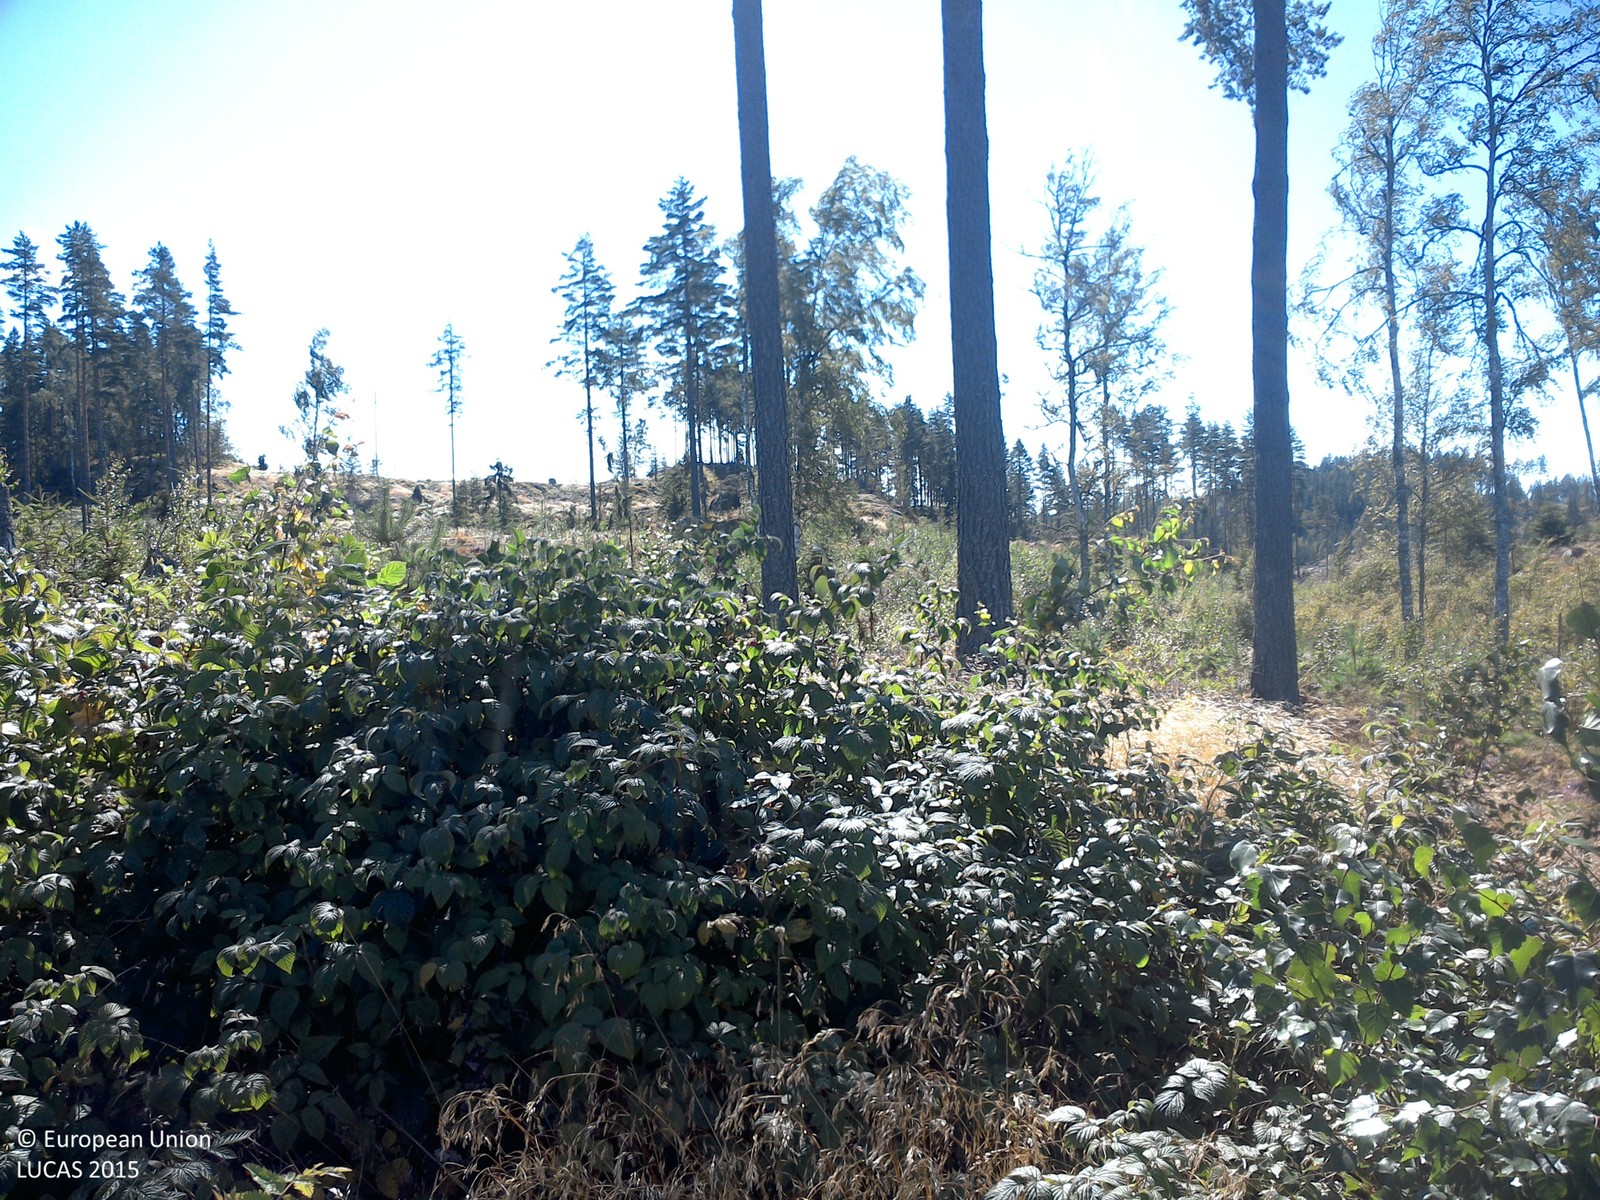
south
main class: Woodland
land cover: Broadleaved woodland
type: boreal forest
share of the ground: 25 - 50 %
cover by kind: herbaceous plants 50 %, broadleaved forest trees 45 %, shrubs 5 %
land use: Forestry
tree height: < 5 m
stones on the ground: < 10 %
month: August
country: SE
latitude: 57.8611
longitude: 15.3384
